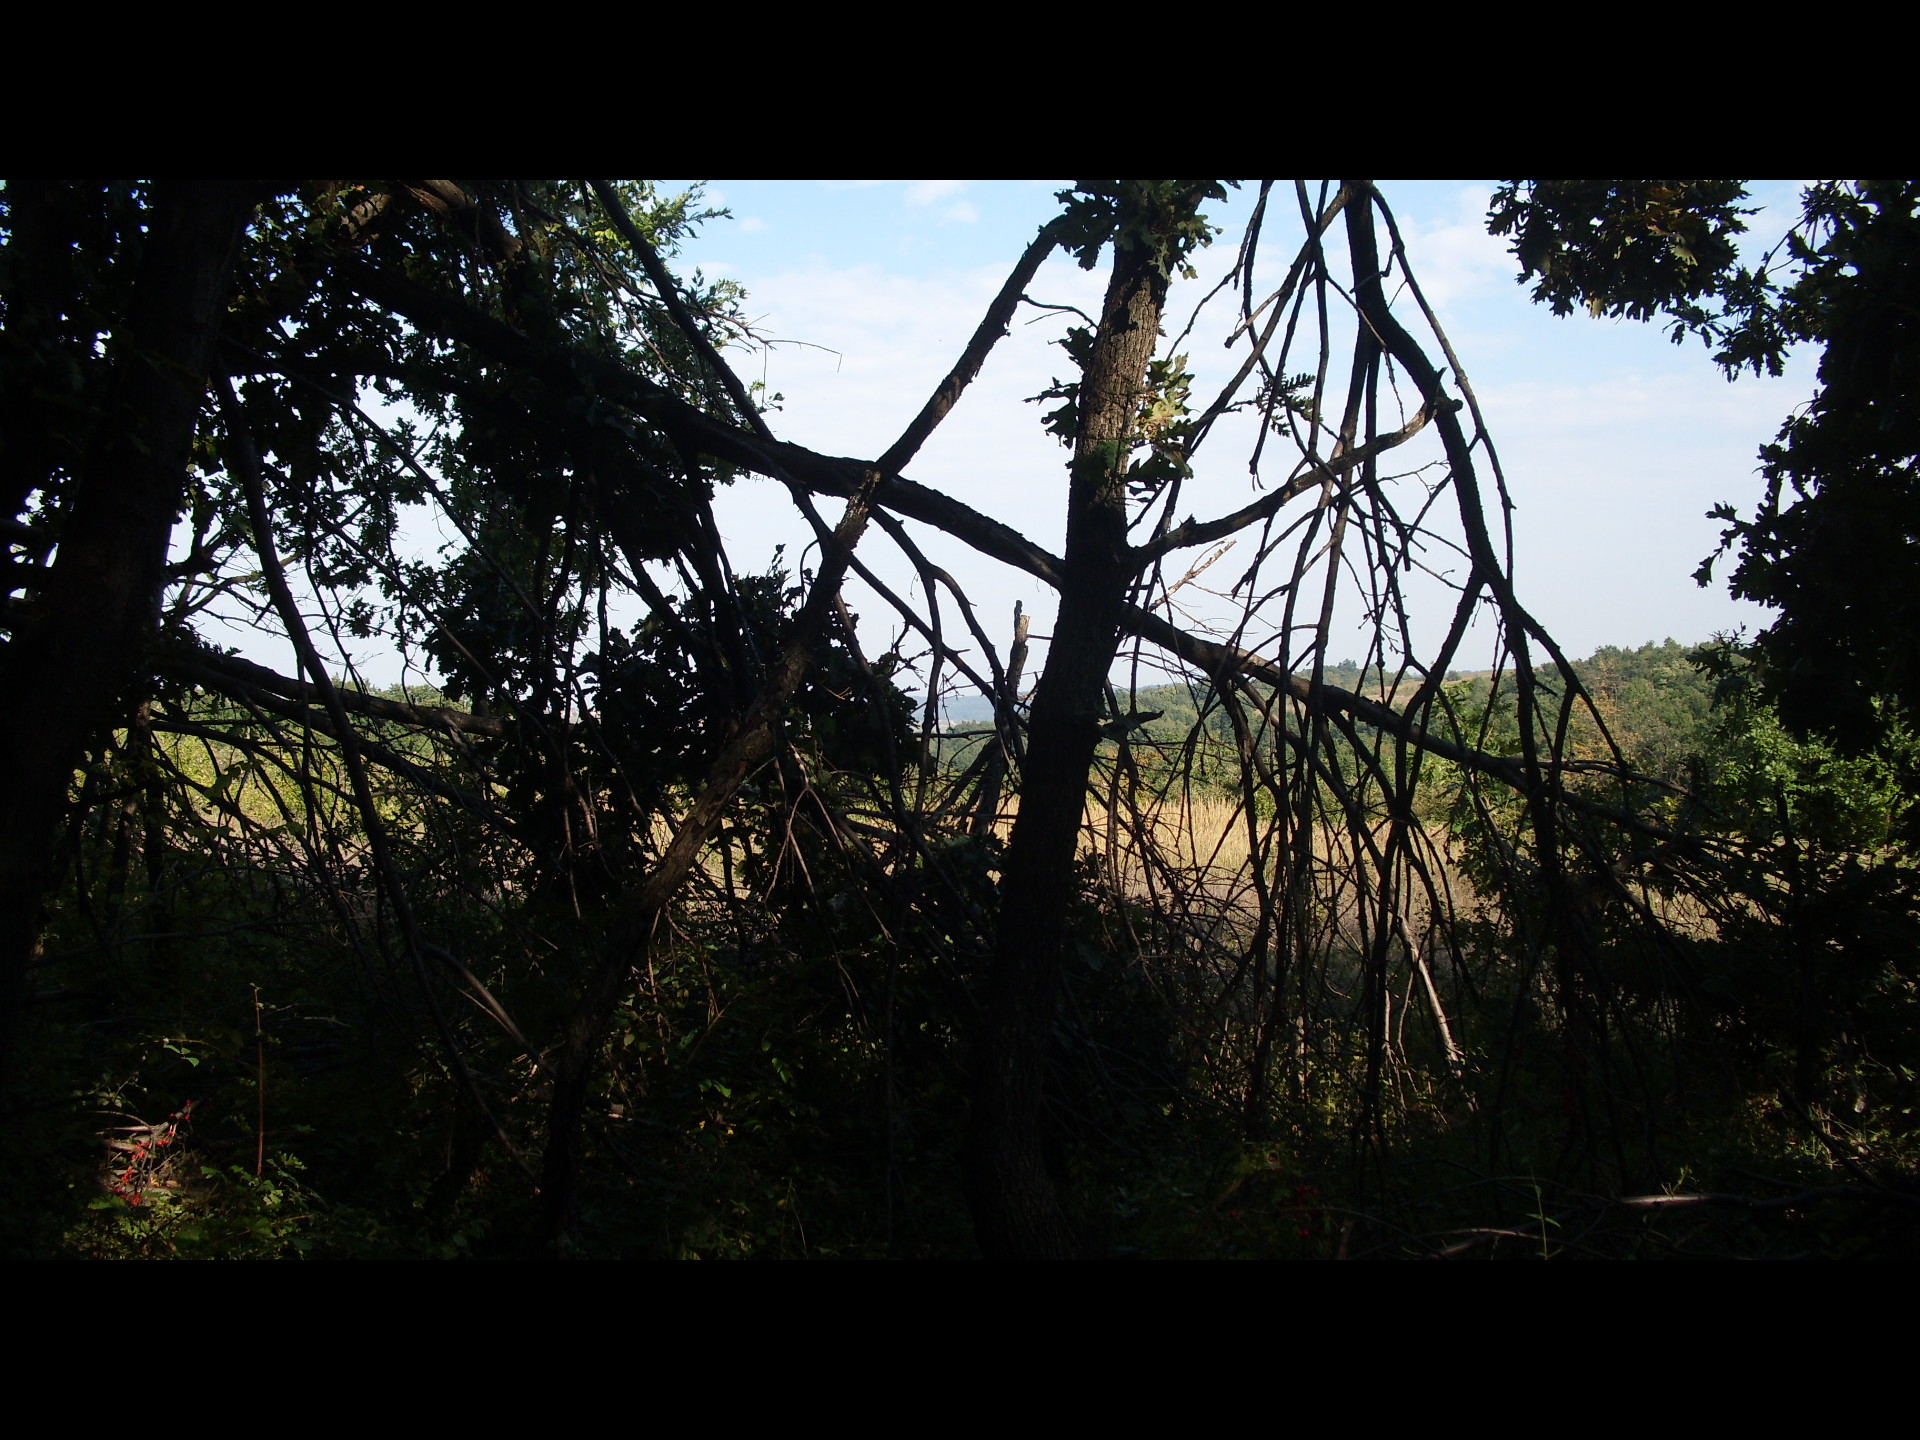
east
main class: Woodland
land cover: Broadleaved woodland
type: mesophytic deciduous forest
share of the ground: > 75 %
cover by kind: broadleaved forest trees 85 %, herbaceous plants 15 %
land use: Forestry
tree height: > 5 m
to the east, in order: Broadleaved woodland; Grassland with sparse tree/shrub cover; Broadleaved woodland; Shrubland without tree cover; Broadleaved woodland
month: October
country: BG
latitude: 43.8693
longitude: 22.4641
